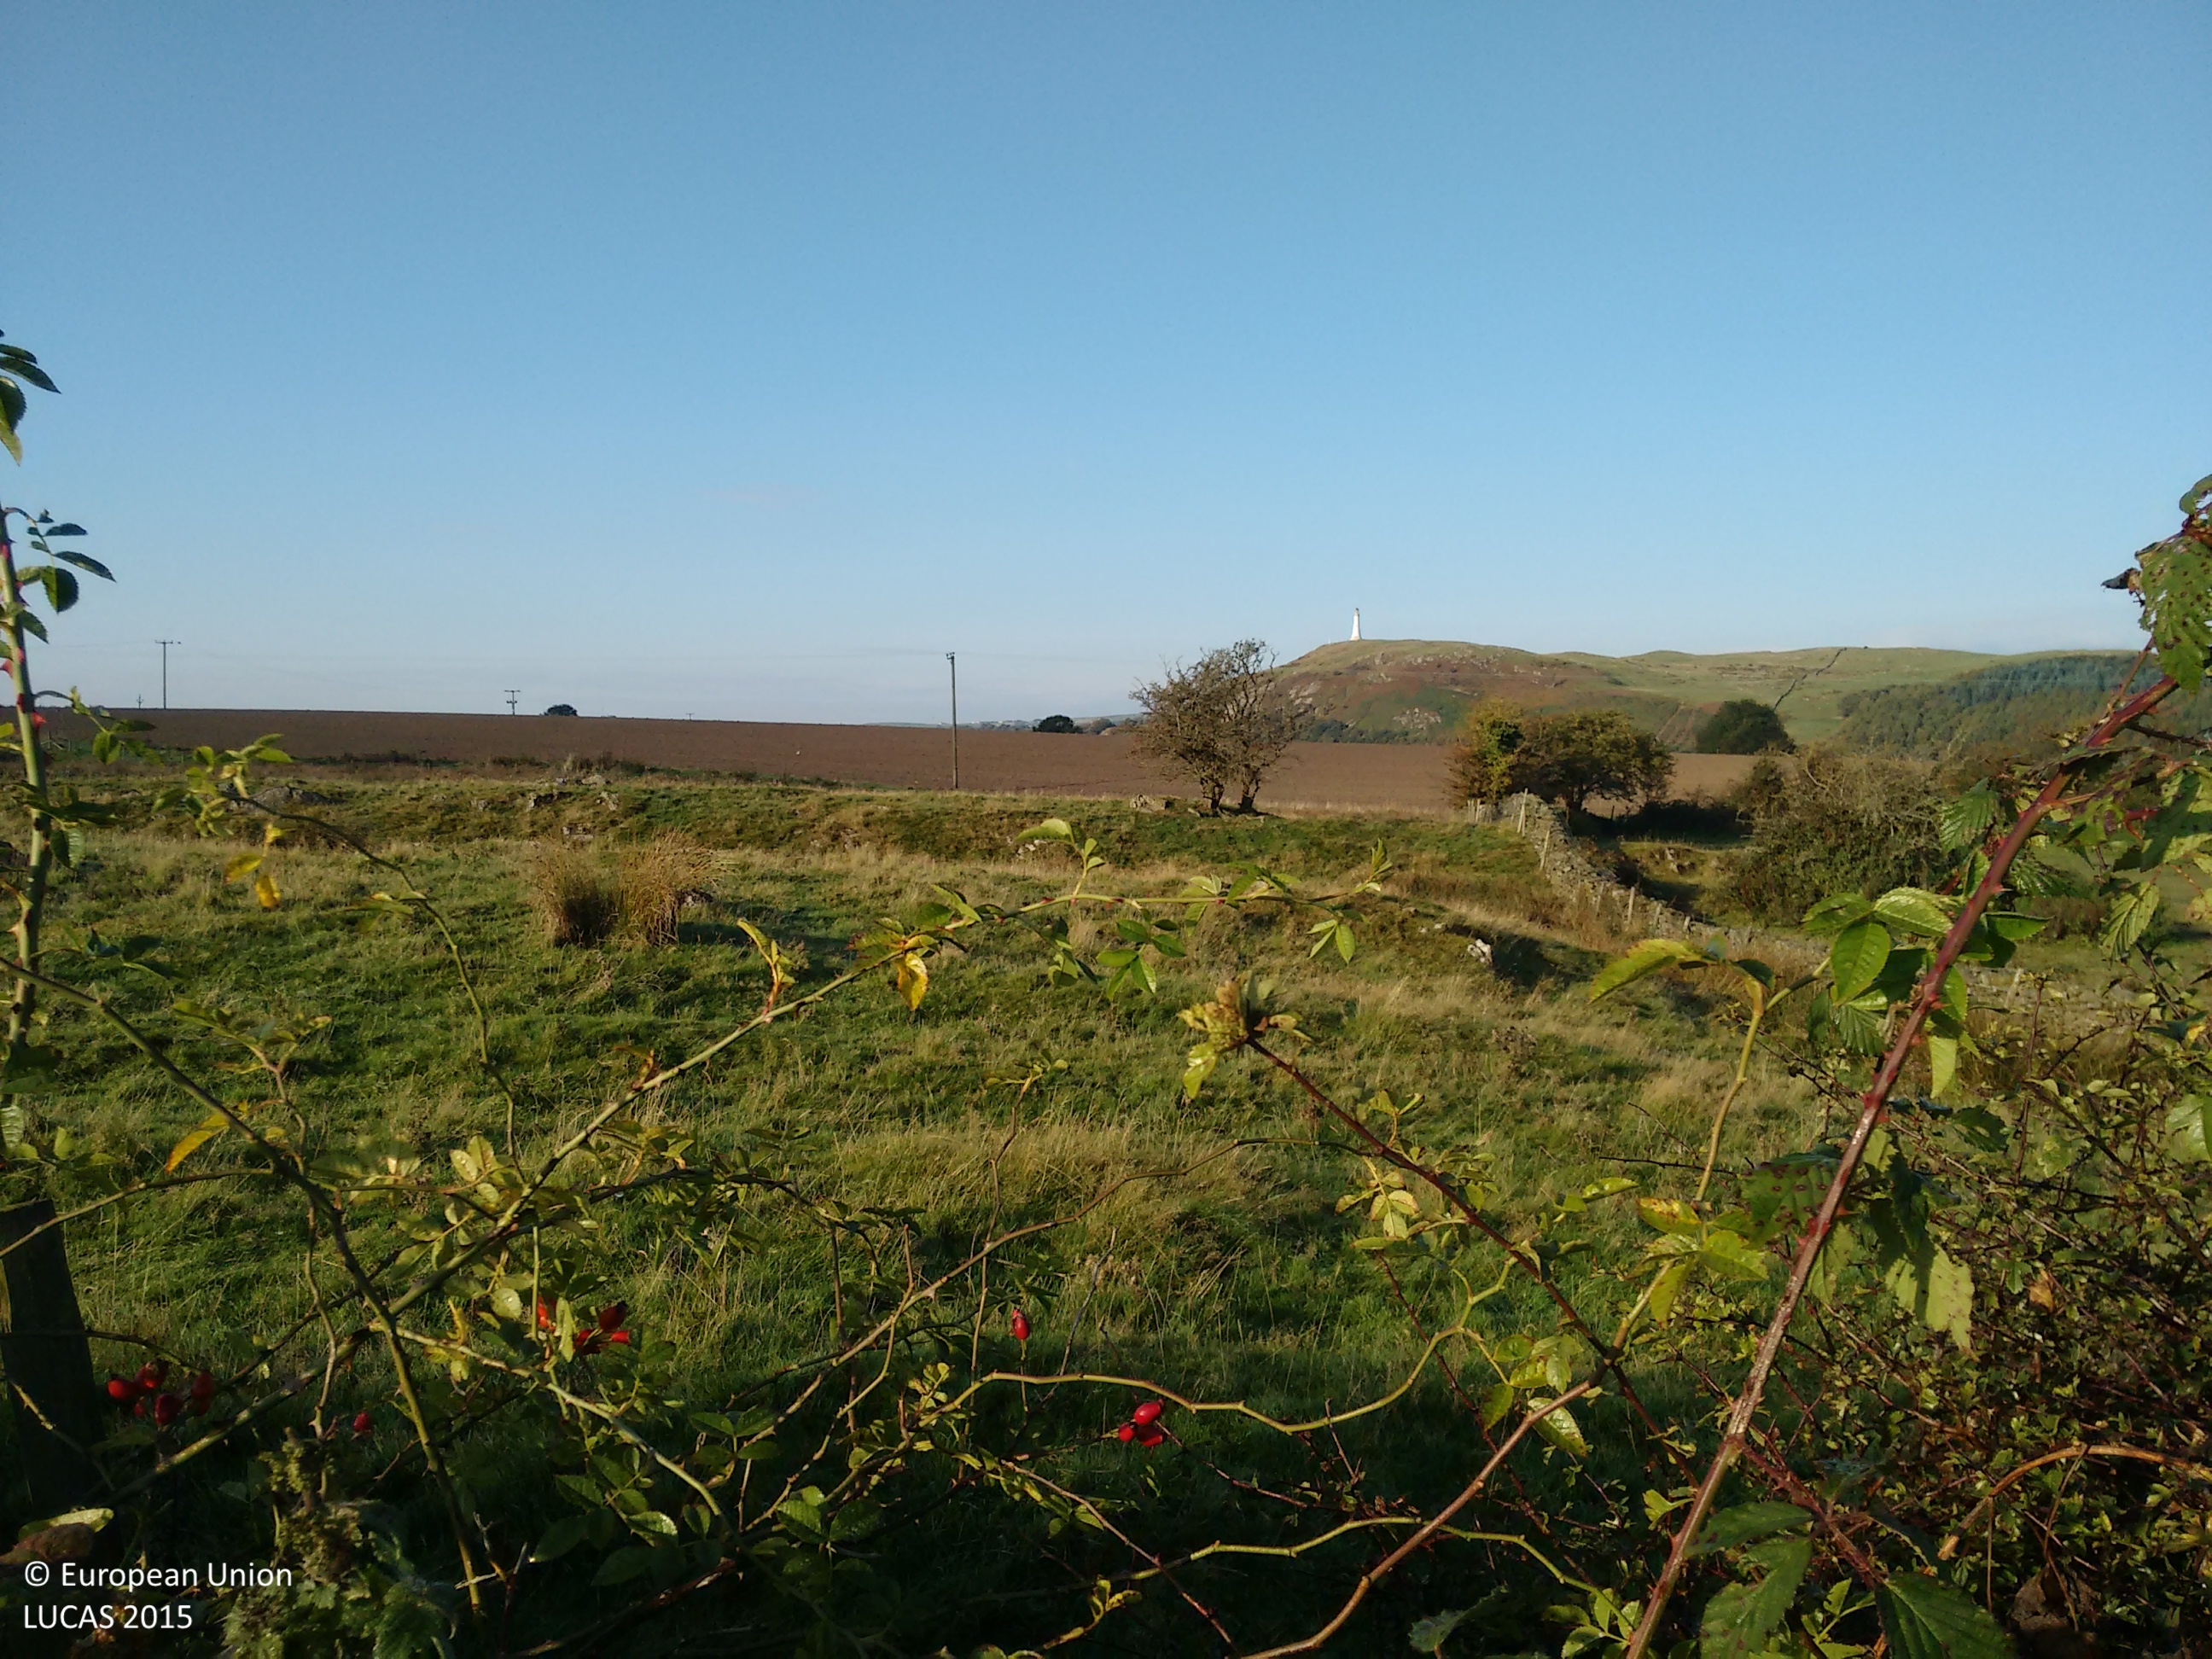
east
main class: Grassland
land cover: Grassland without tree/shrub cover
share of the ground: > 75 %
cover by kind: herbaceous plants 100 %
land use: Agriculture (excluding fallow land and kitchen gardens)
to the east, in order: Grassland without tree/shrub cover; Rock outcrops; Grassland without tree/shrub cover; Fences; Managed hedges; Paved roads, cycling and walking lanes; Managed hedges; Fences; Grassland without tree/shrub cover; Broadleaved woodland; Rivers and streams; Broadleaved woodland; Grassland without tree/shrub cover
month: October
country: GB
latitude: 54.2037
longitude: -3.0592
